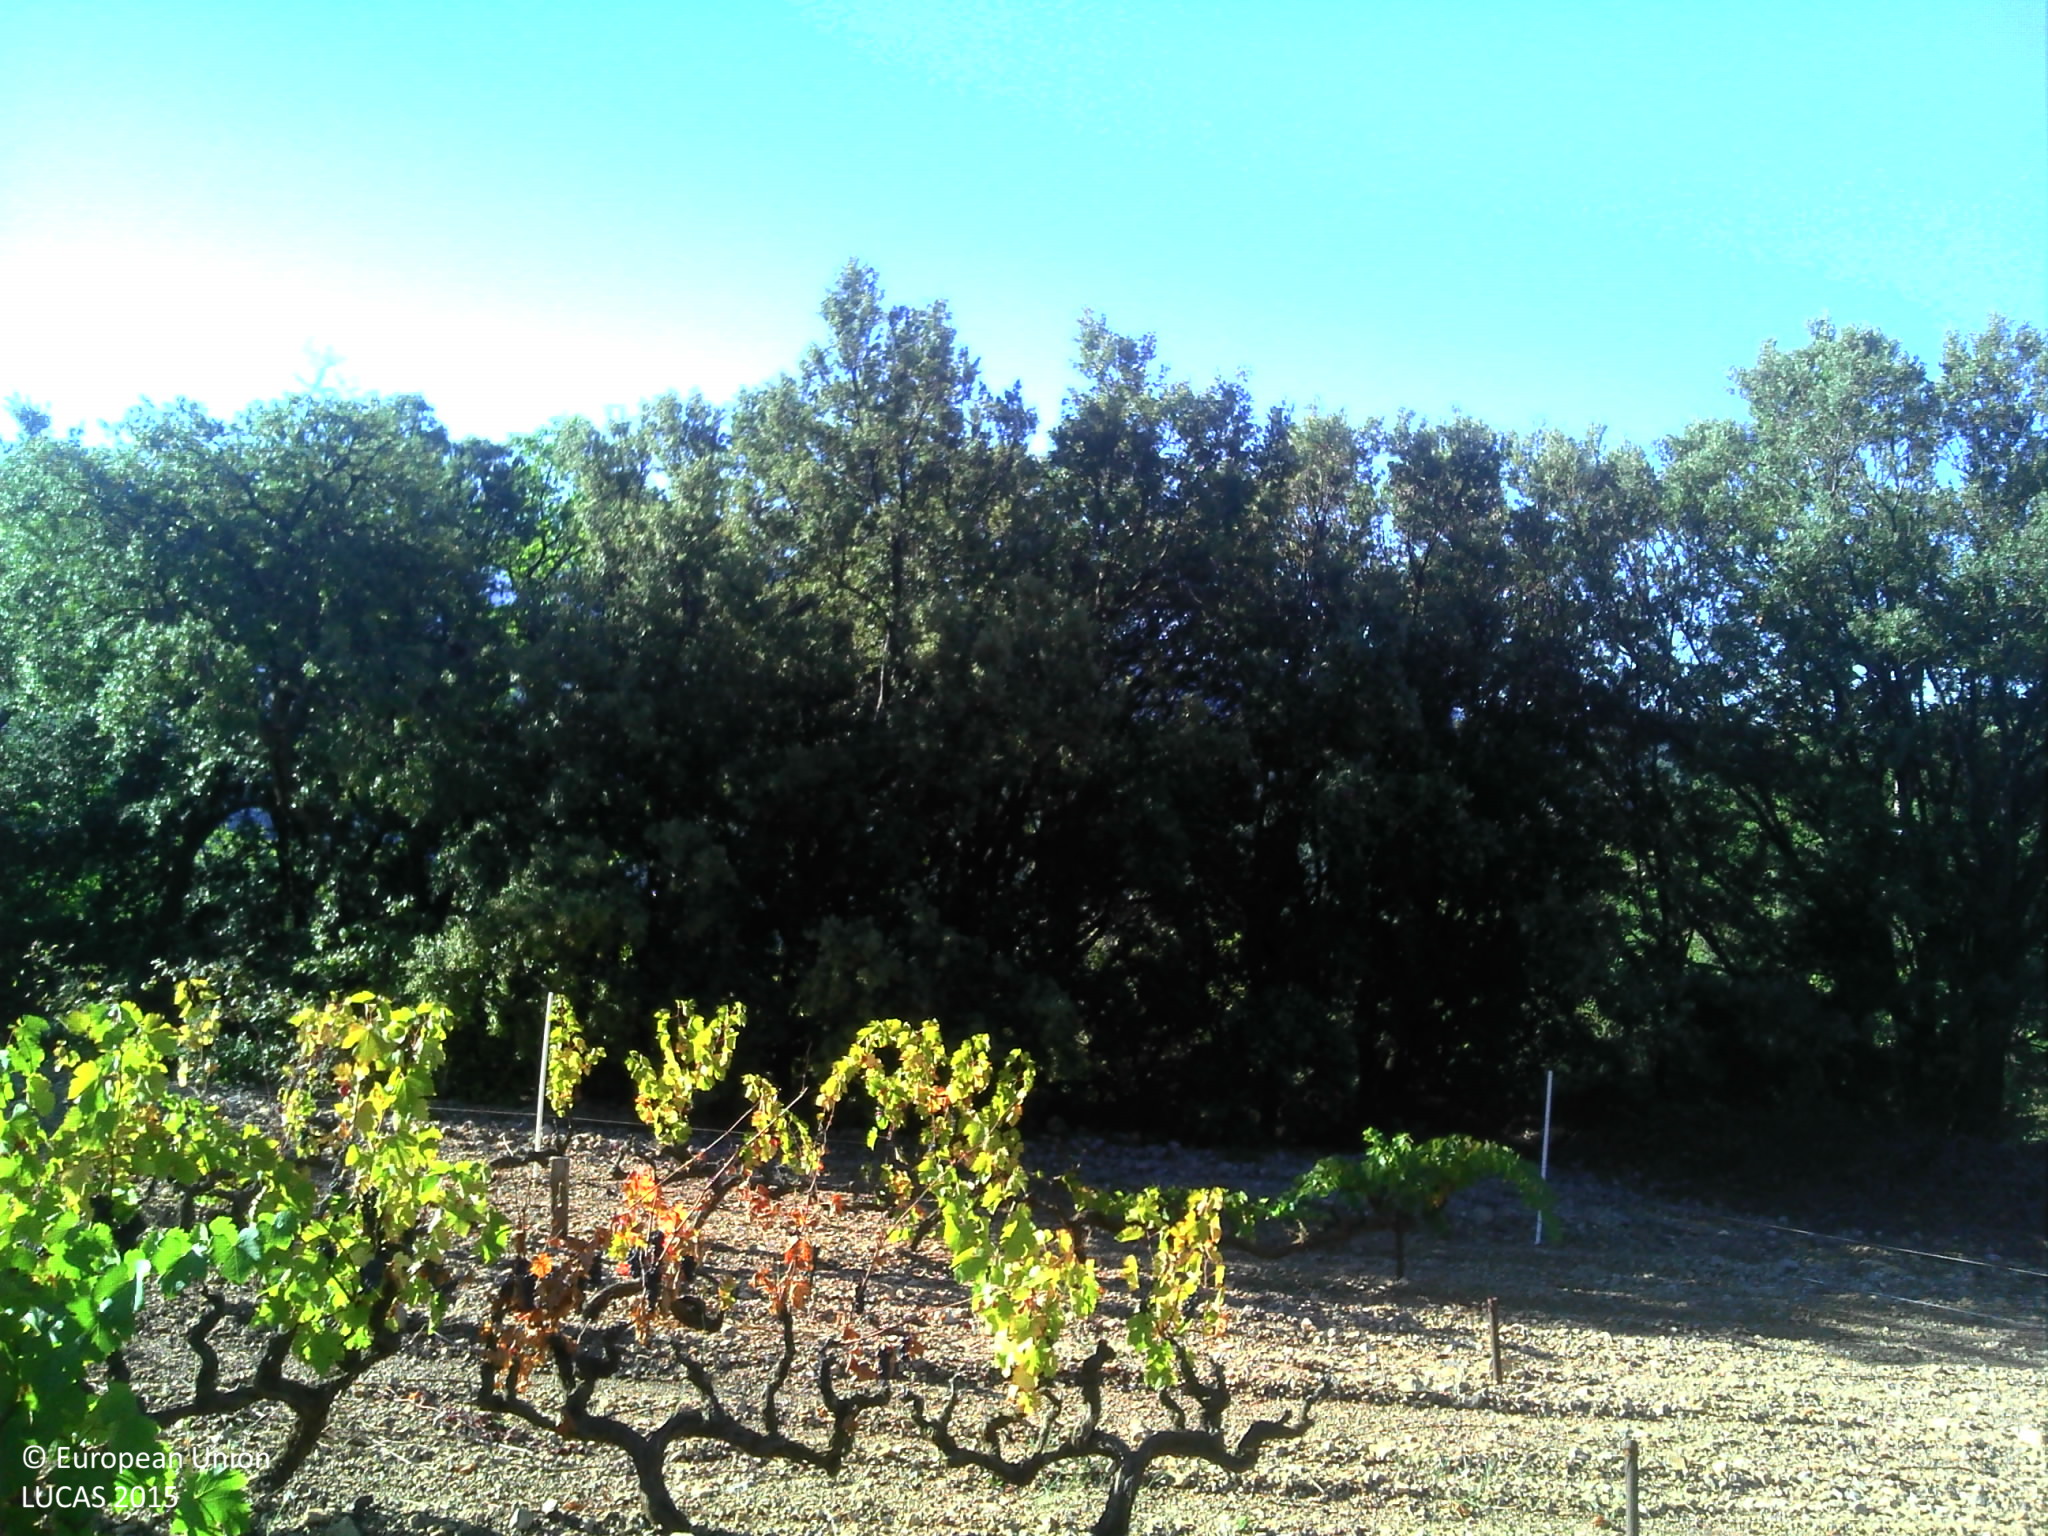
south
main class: Cropland
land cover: Vineyards
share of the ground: 25 - 50 %
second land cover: Other bare soil
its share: > 75 %
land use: Agriculture (excluding fallow land and kitchen gardens)
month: September
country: FR
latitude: 44.2952
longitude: 5.2324
